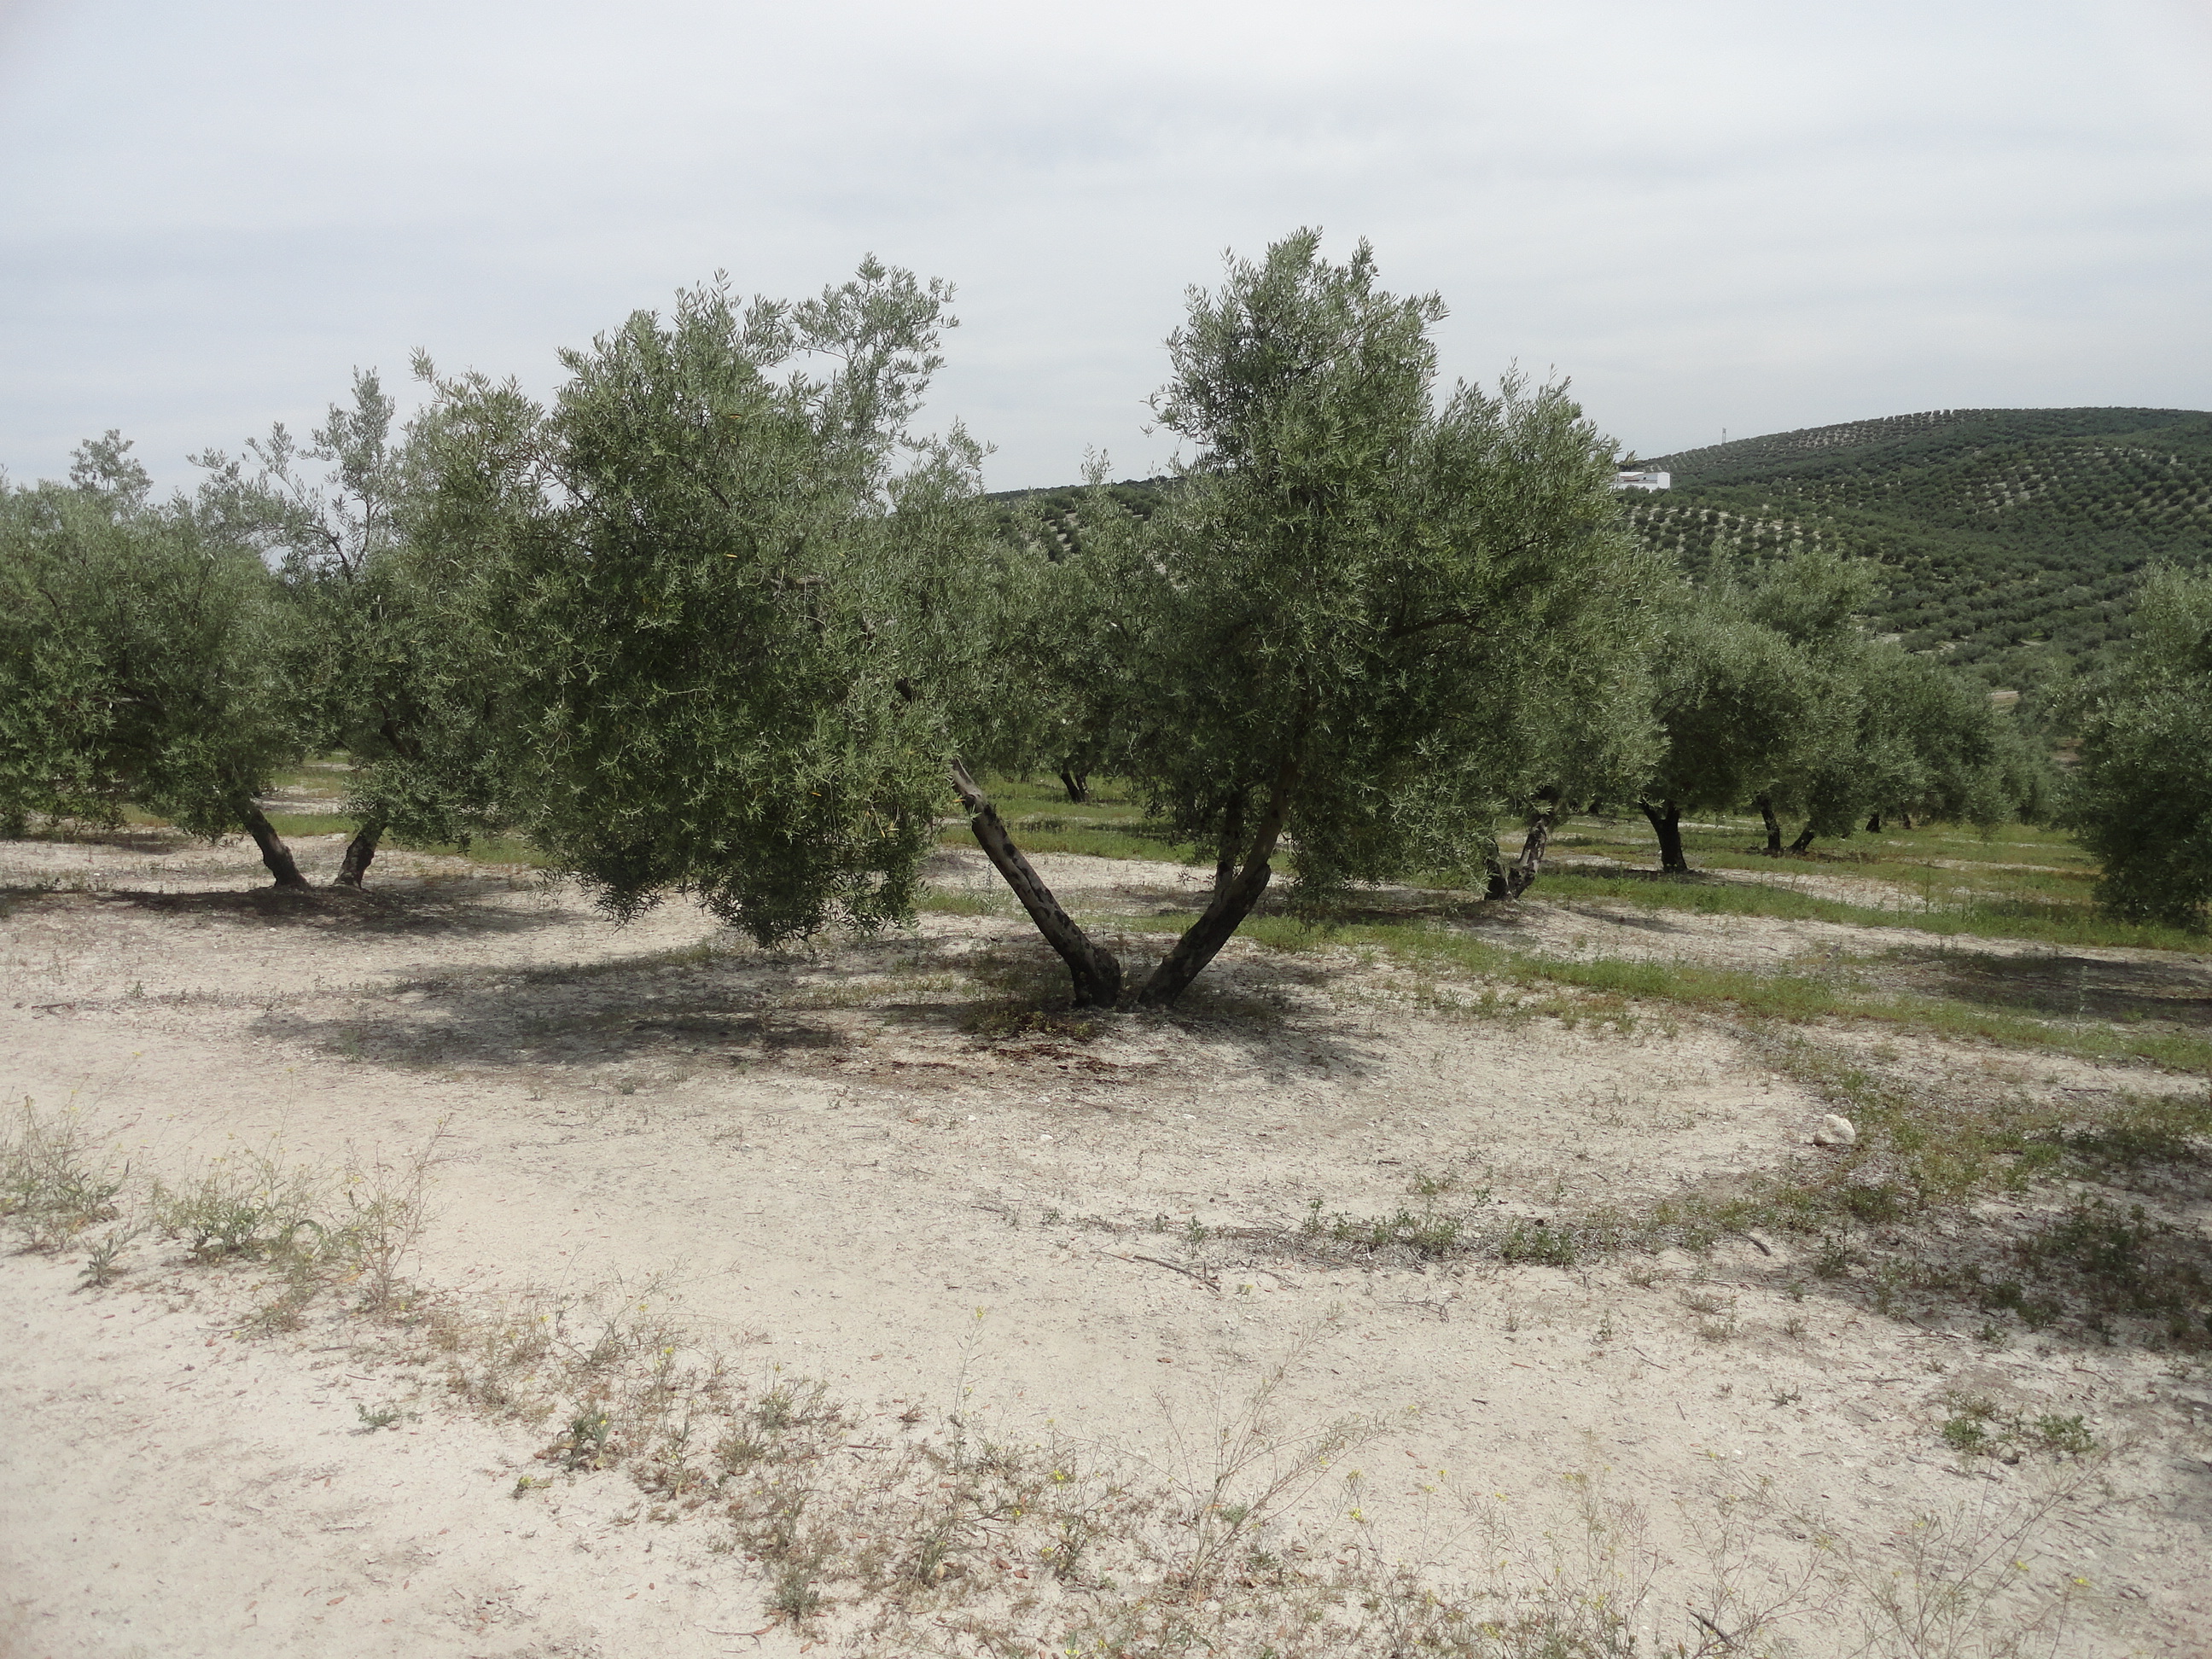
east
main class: Cropland
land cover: Olive groves
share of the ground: 50 - 75 %
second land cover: Spontaneously vegetated surfaces
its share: 10 - 25 %
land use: Agriculture (excluding fallow land and kitchen gardens)
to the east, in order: Olive groves; Spontaneously vegetated surfaces; Grass margins; Olive groves; Ditches and canals; Grass margins; Tracks; Grass margins; Olive groves
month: April
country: ES
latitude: 37.6121
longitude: -4.4494
